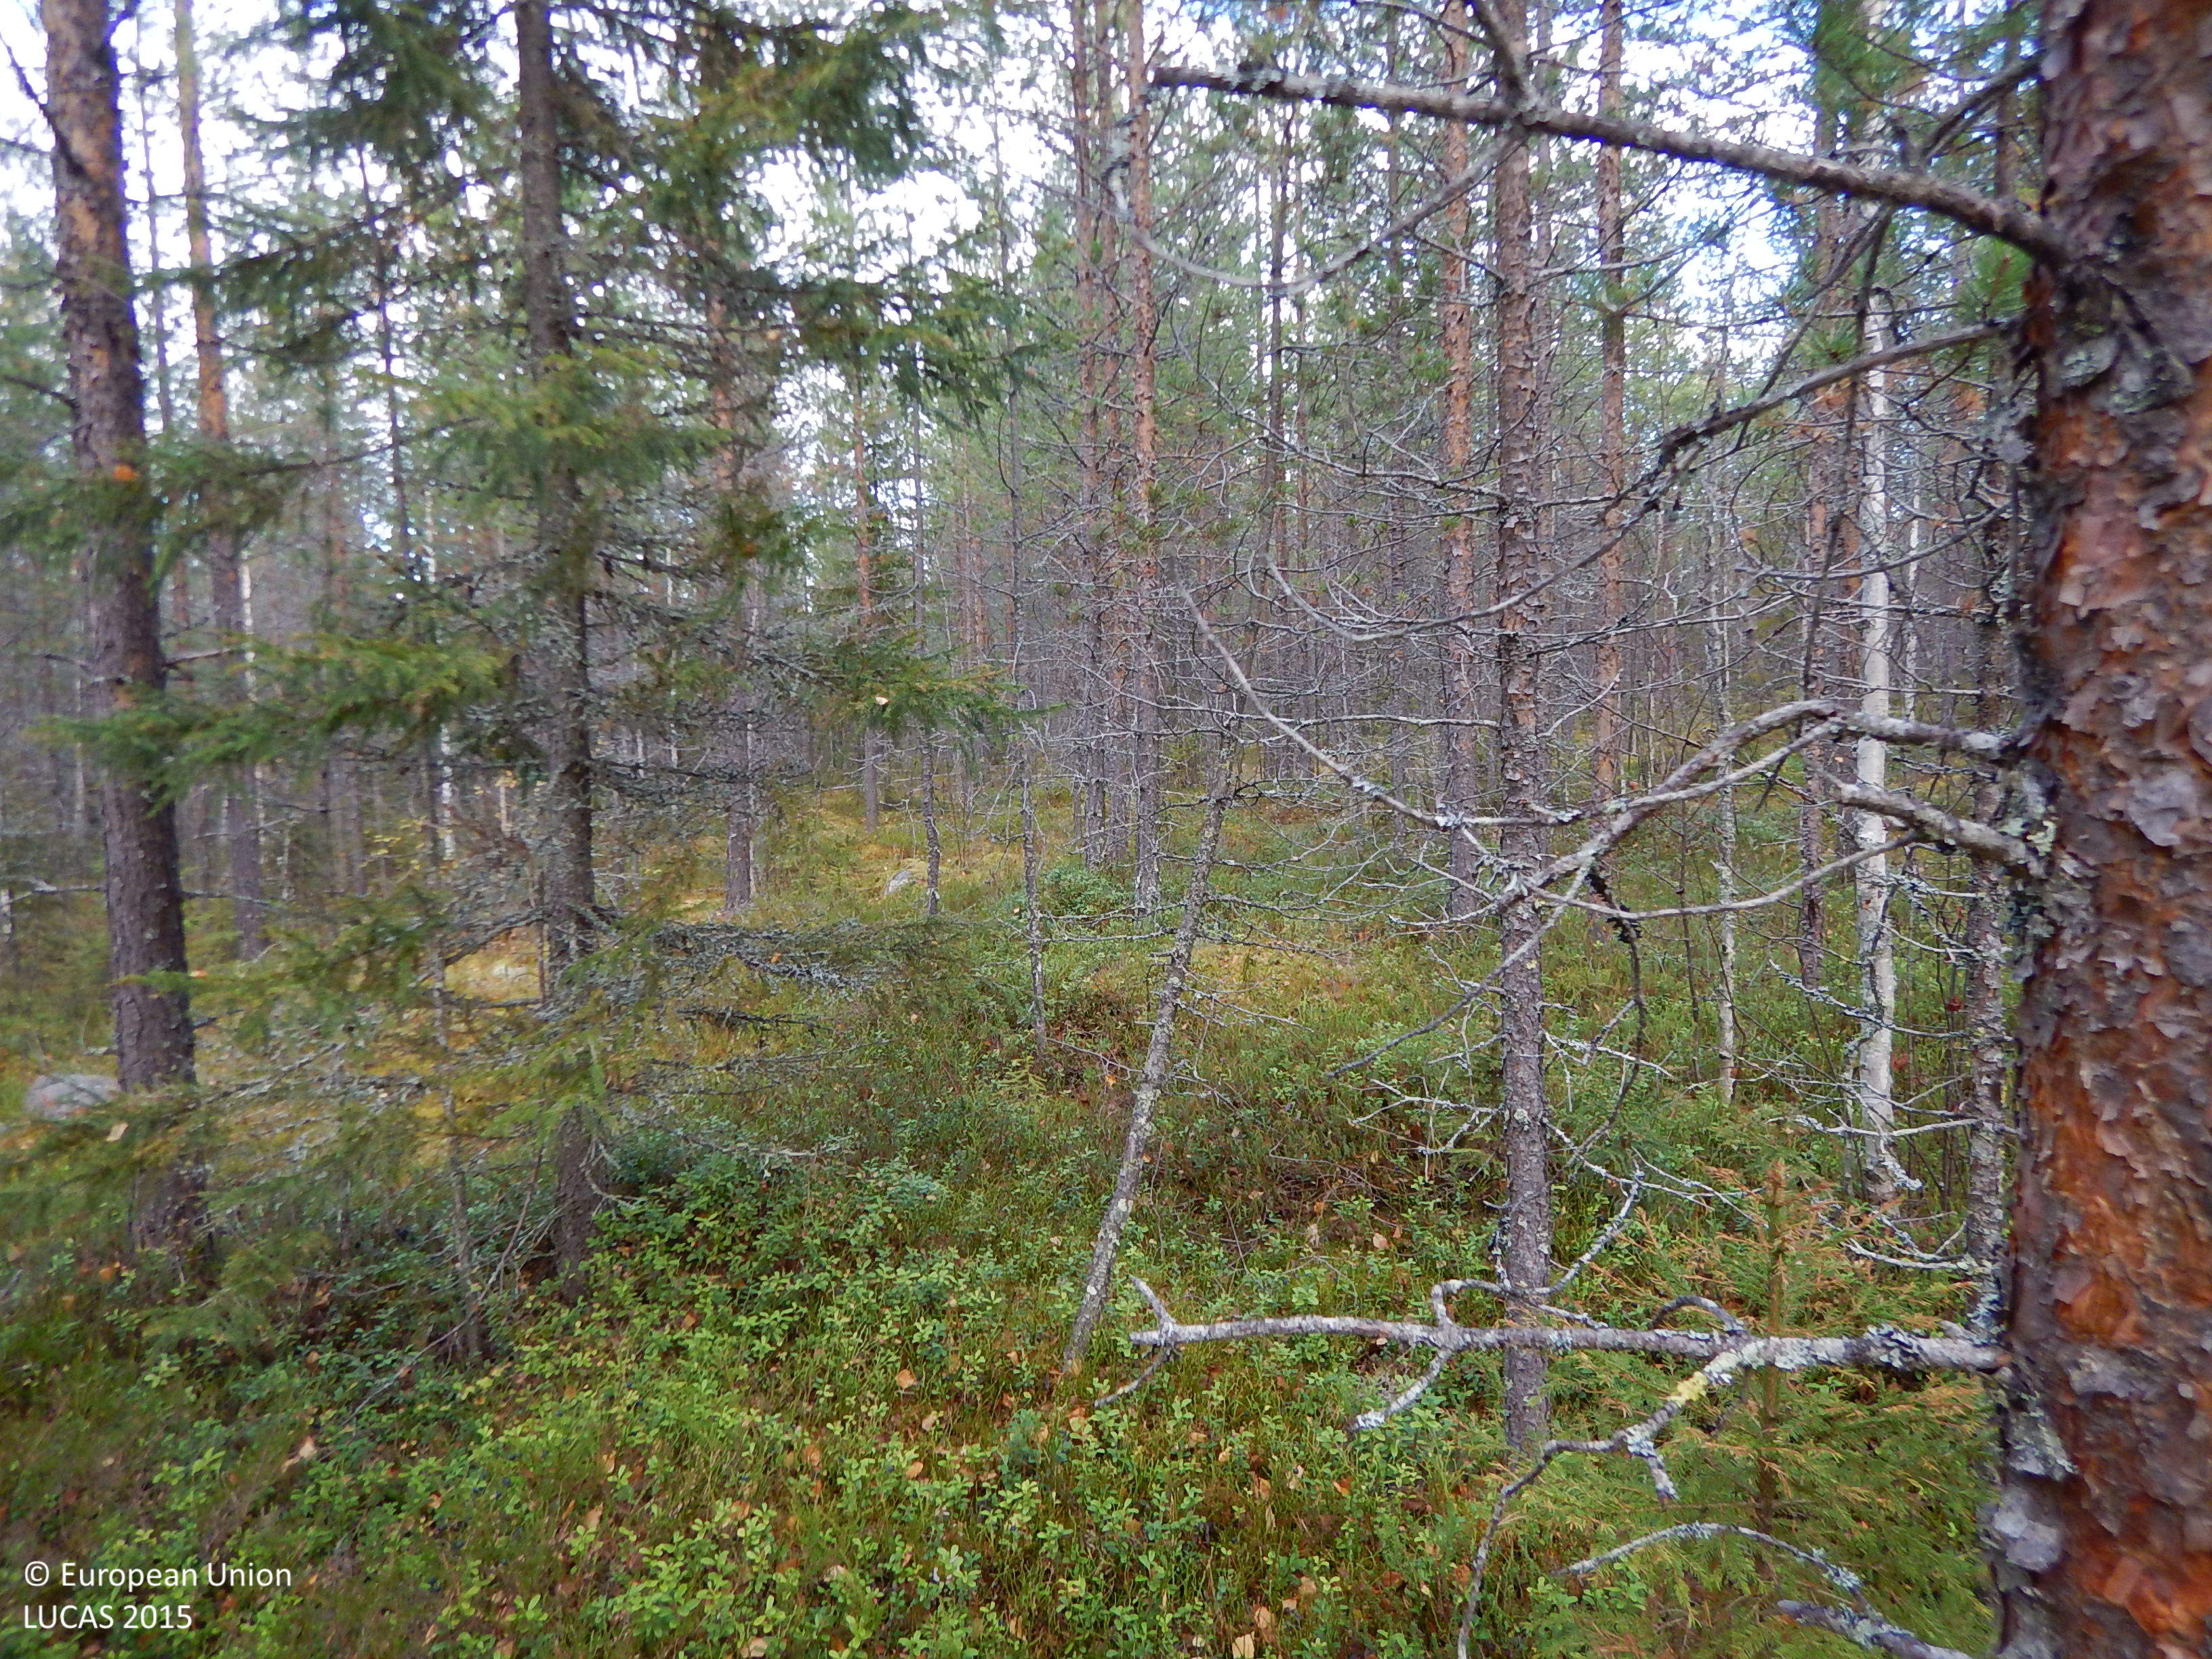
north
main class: Woodland
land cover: Pine dominated mixed woodland
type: boreal forest
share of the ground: 50 - 75 %
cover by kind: coniferous forest trees 45 %, broadleaved forest trees 20 %, shrubs 15 %, herbaceous plants 10 %, lichens and mosses 10 %
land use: Forestry
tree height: > 5 m
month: October
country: SE
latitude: 65.0918
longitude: 21.0191
